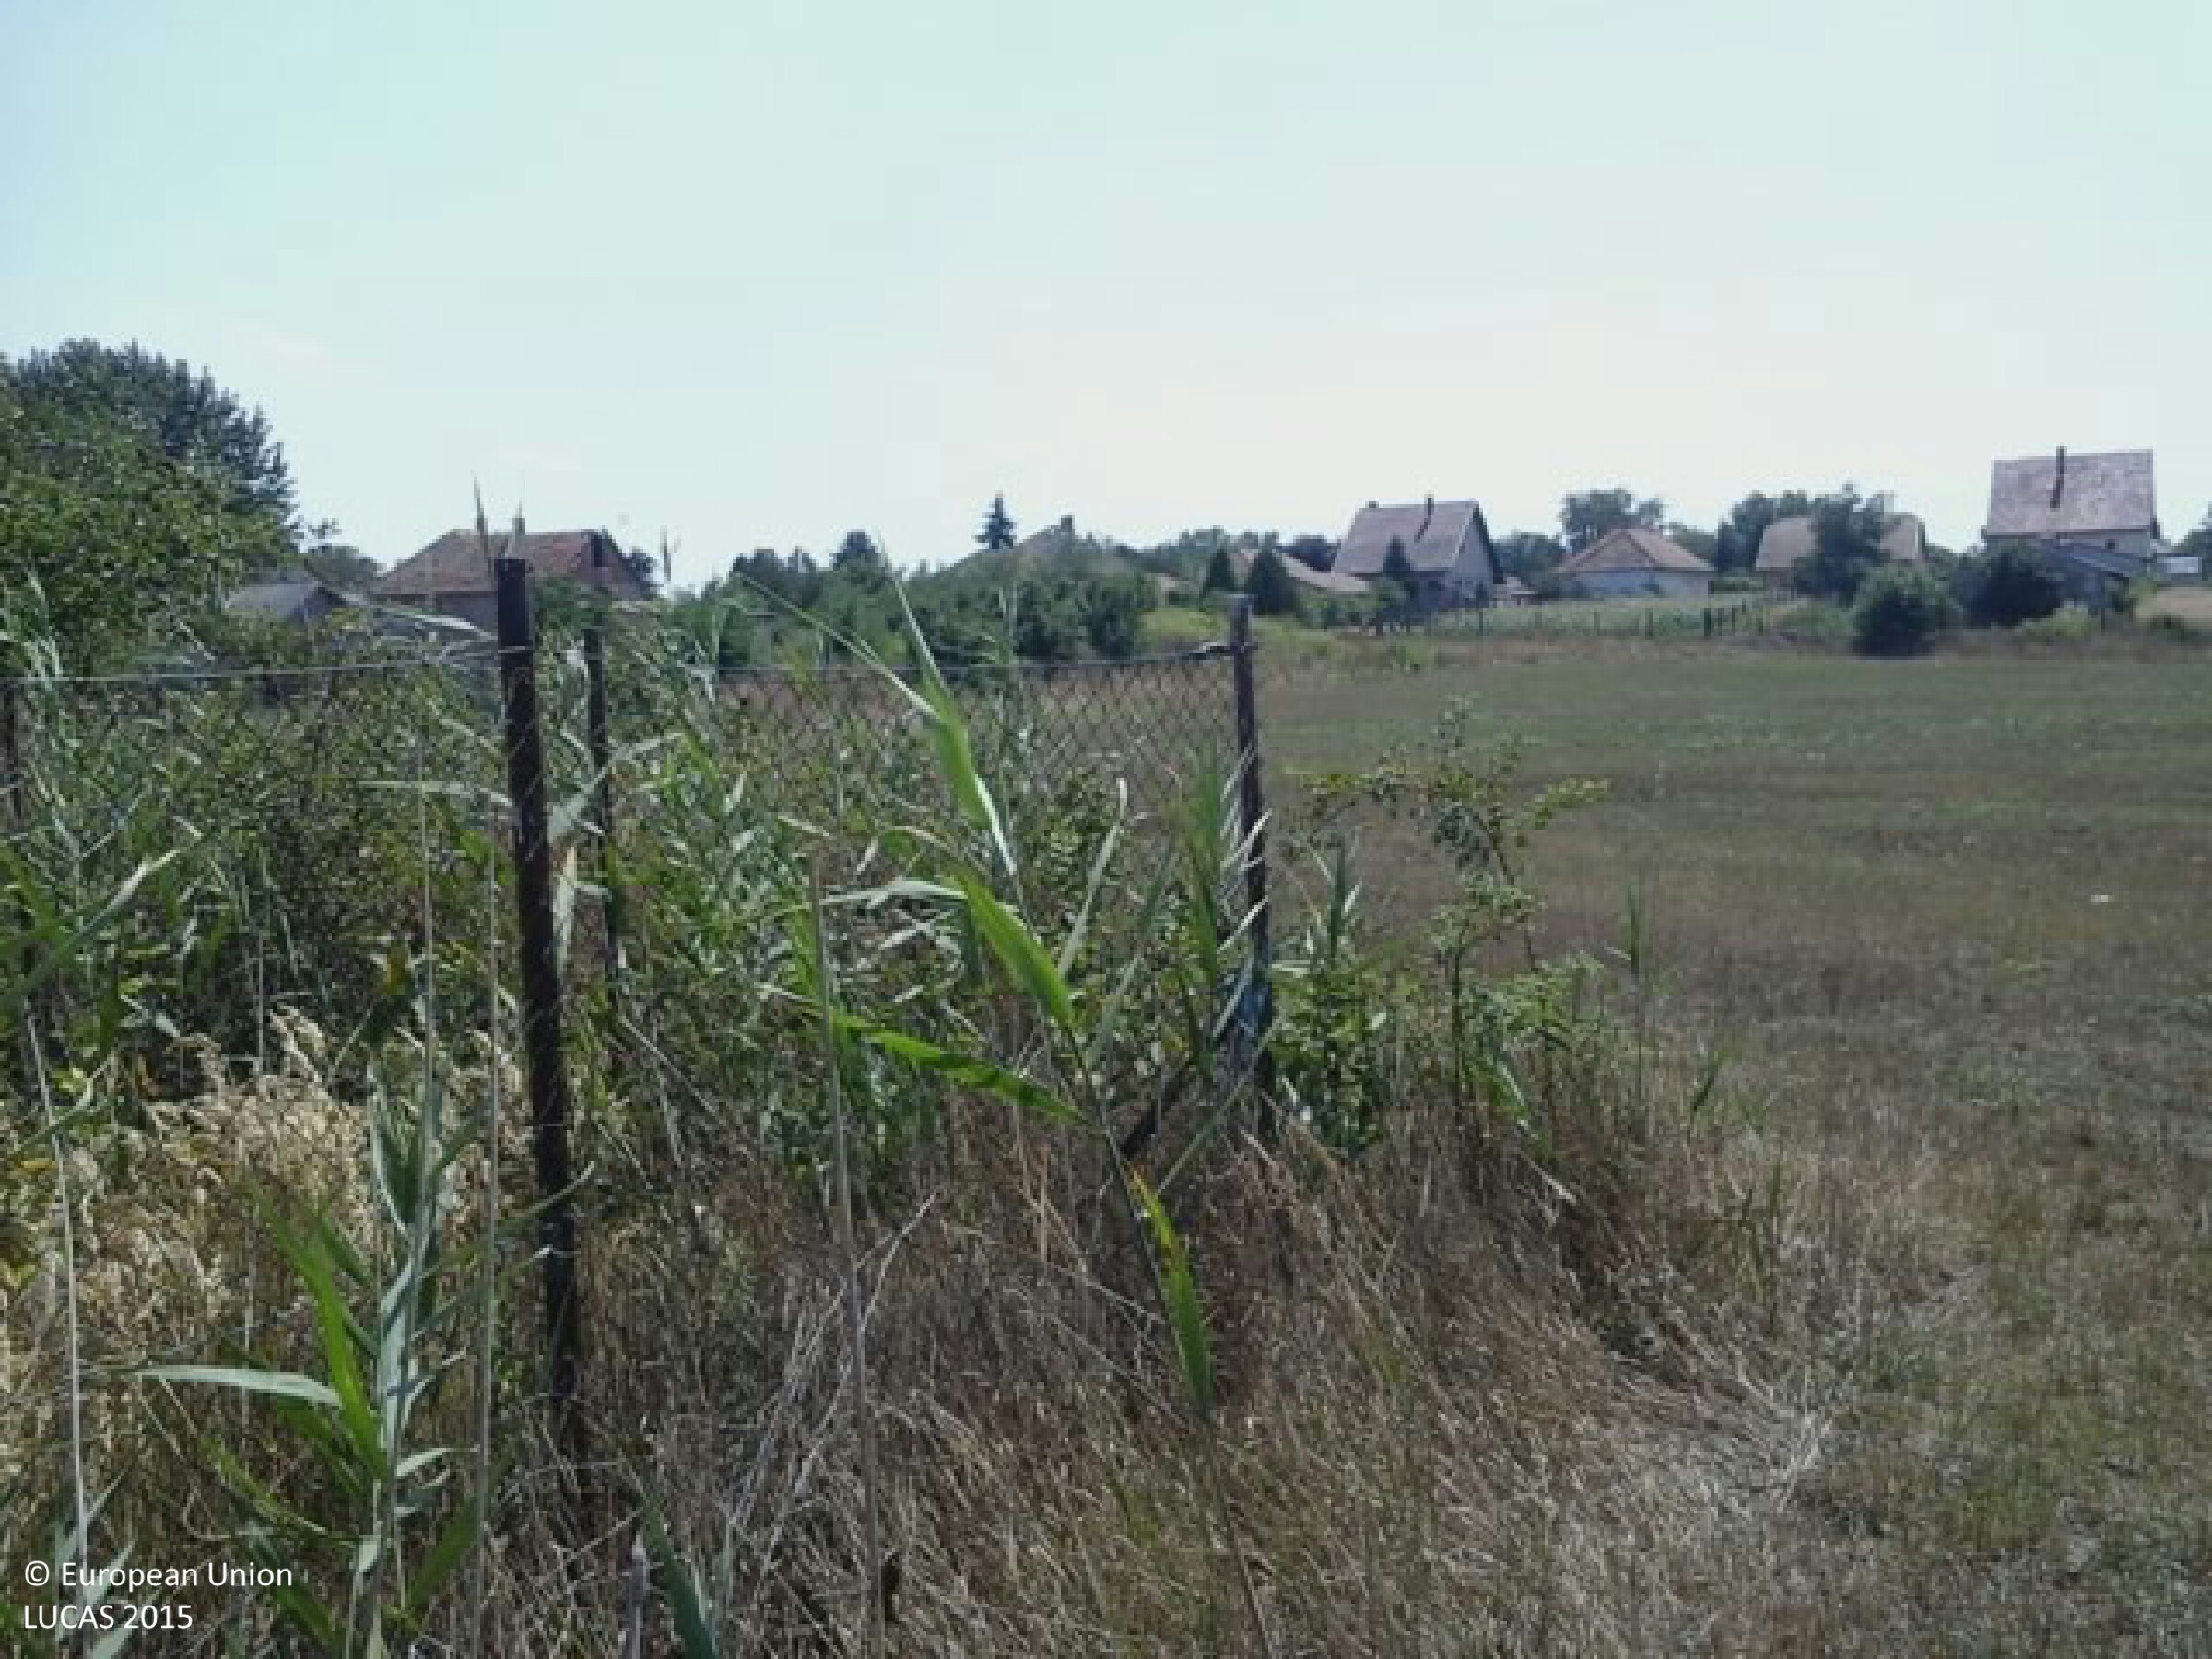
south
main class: Grassland
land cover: Grassland without tree/shrub cover
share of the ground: > 75 %
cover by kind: herbaceous plants 100 %
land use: Agriculture (excluding fallow land and kitchen gardens)
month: August
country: HU
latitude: 47.2448
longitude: 19.3598
